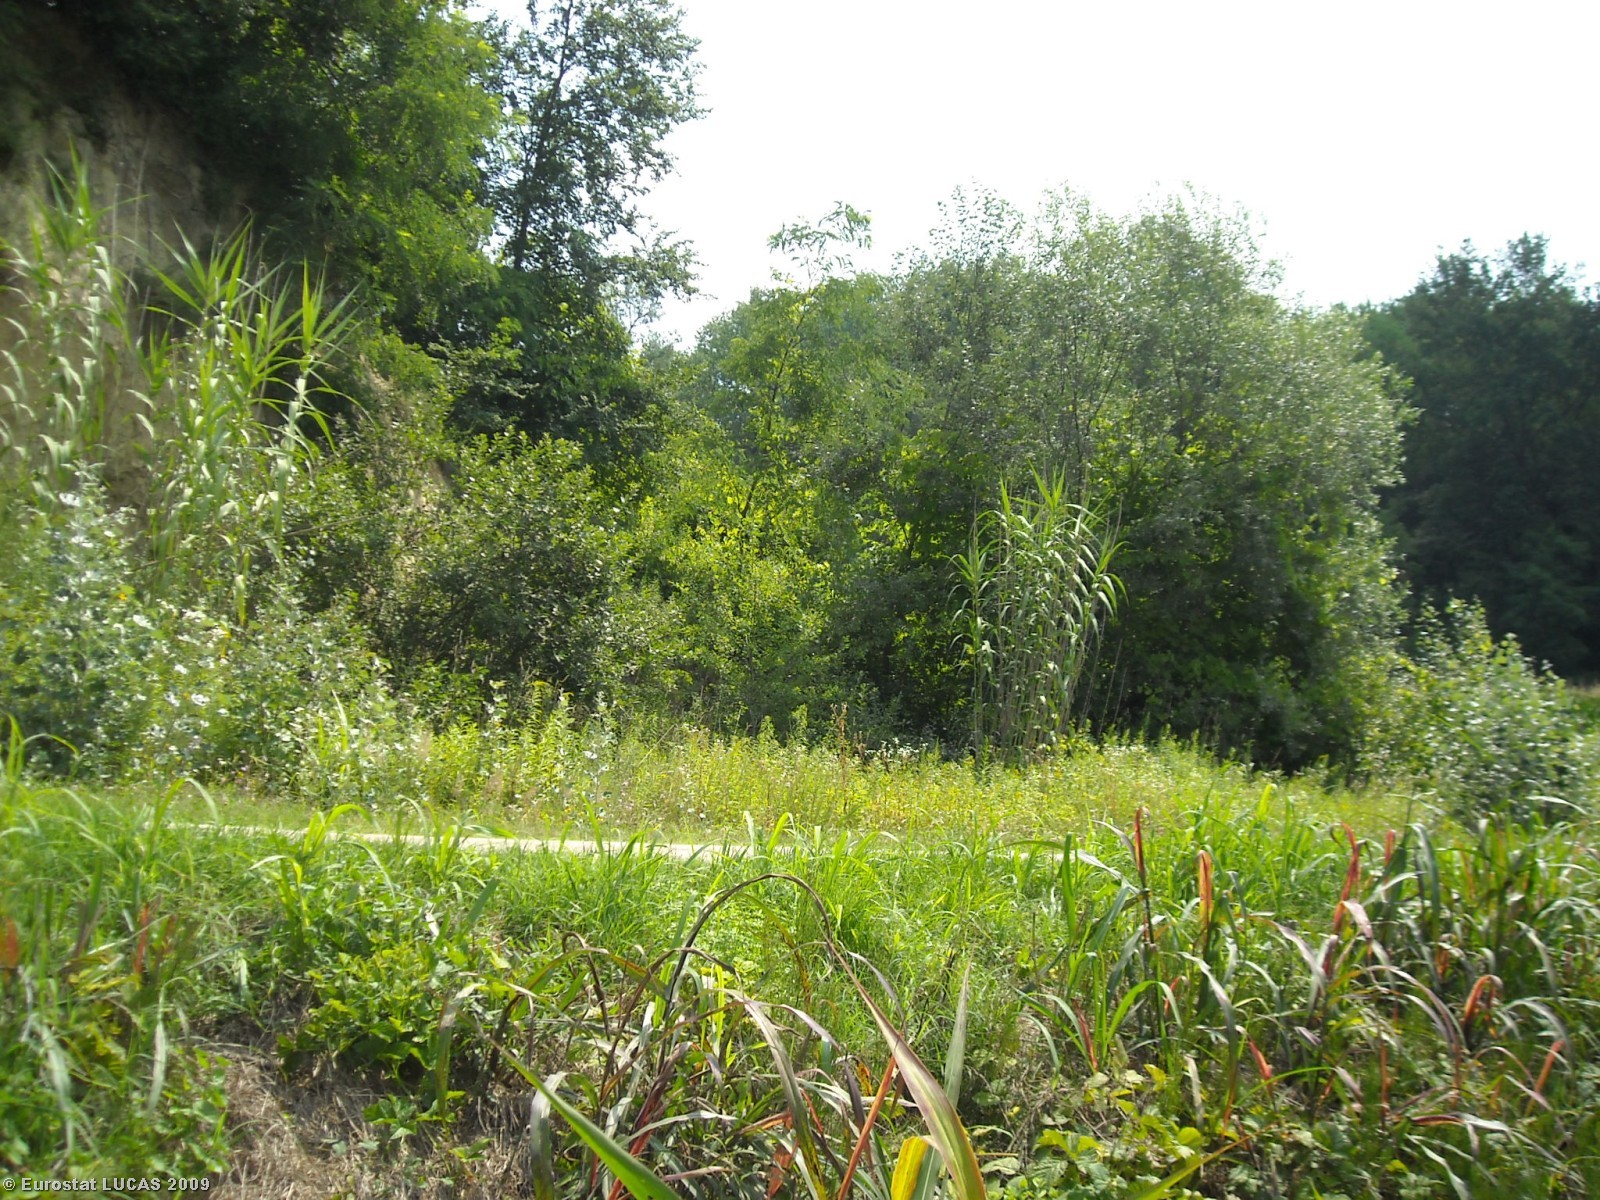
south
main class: Cropland
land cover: Maize
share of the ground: > 75 %
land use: Agriculture (excluding fallow land and kitchen gardens)
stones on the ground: < 10 %
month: July
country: IT
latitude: 44.9643
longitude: 8.0892
